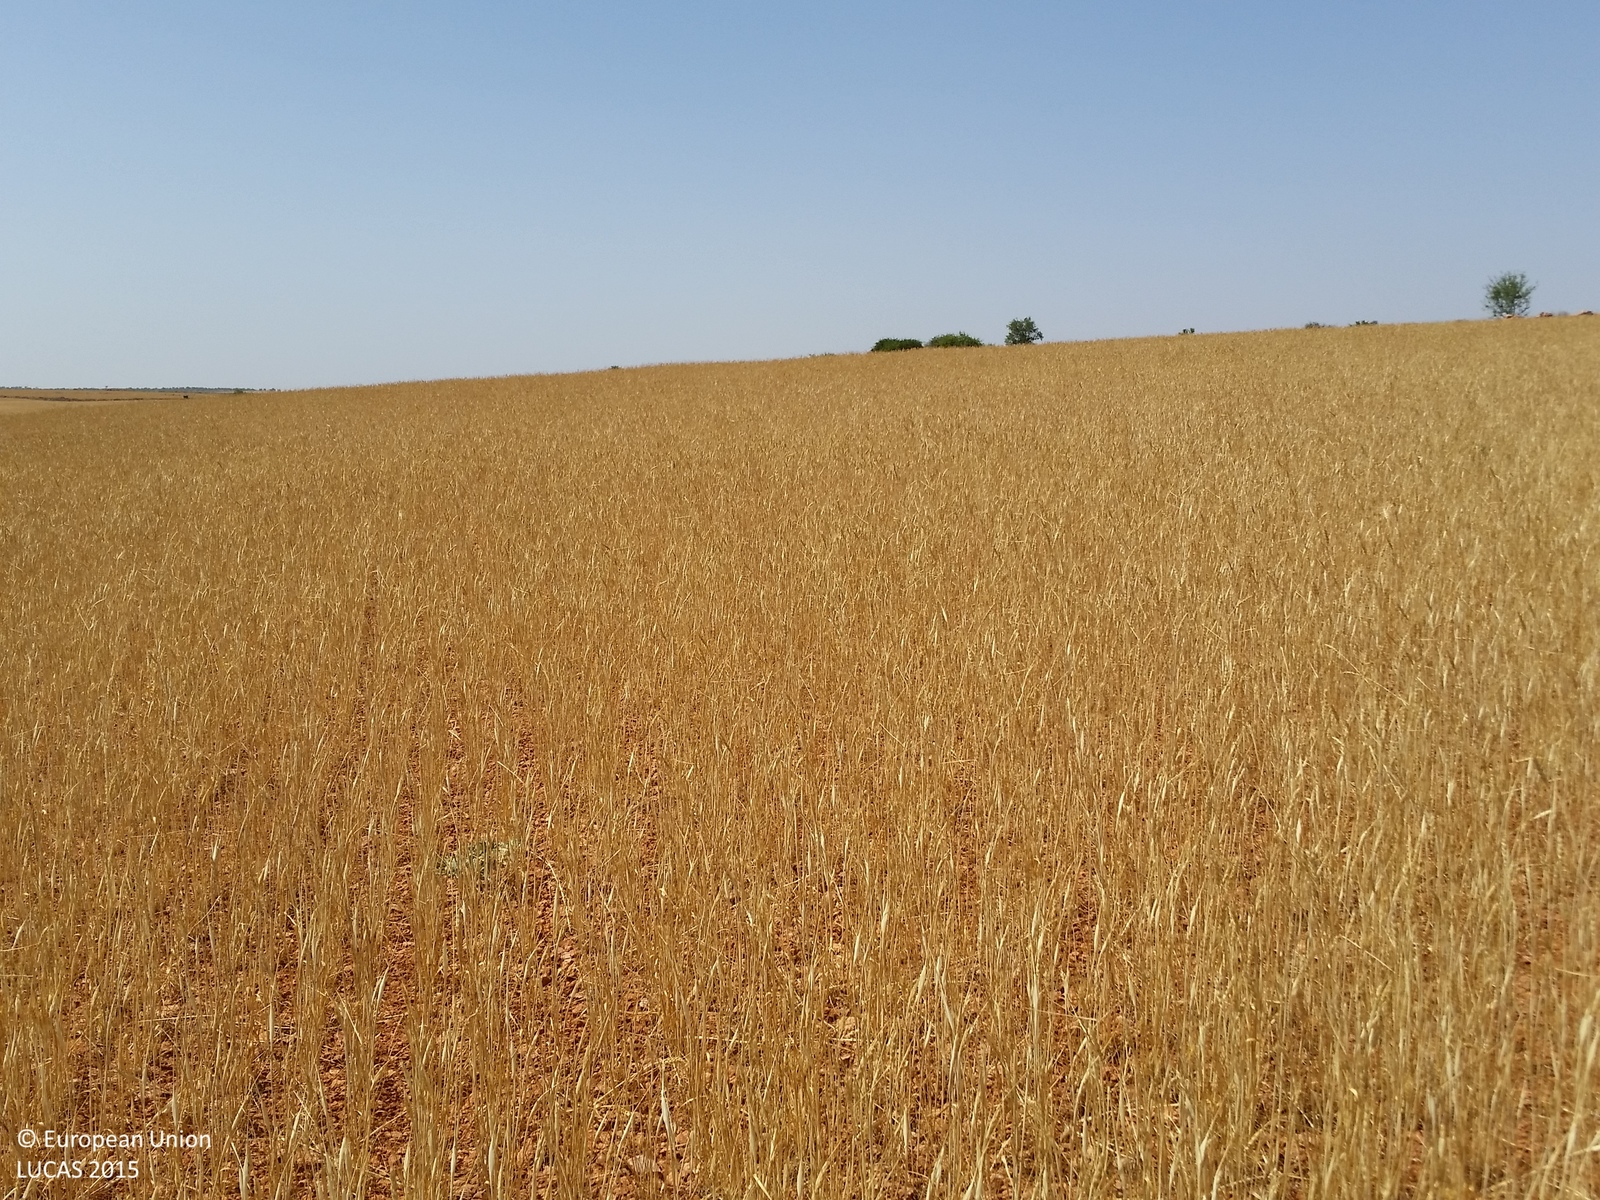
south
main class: Cropland
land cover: Common wheat
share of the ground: > 75 %
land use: Agriculture (excluding fallow land and kitchen gardens)
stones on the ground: 10 - 25 %
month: July
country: ES
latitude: 38.9045
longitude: -2.5857
